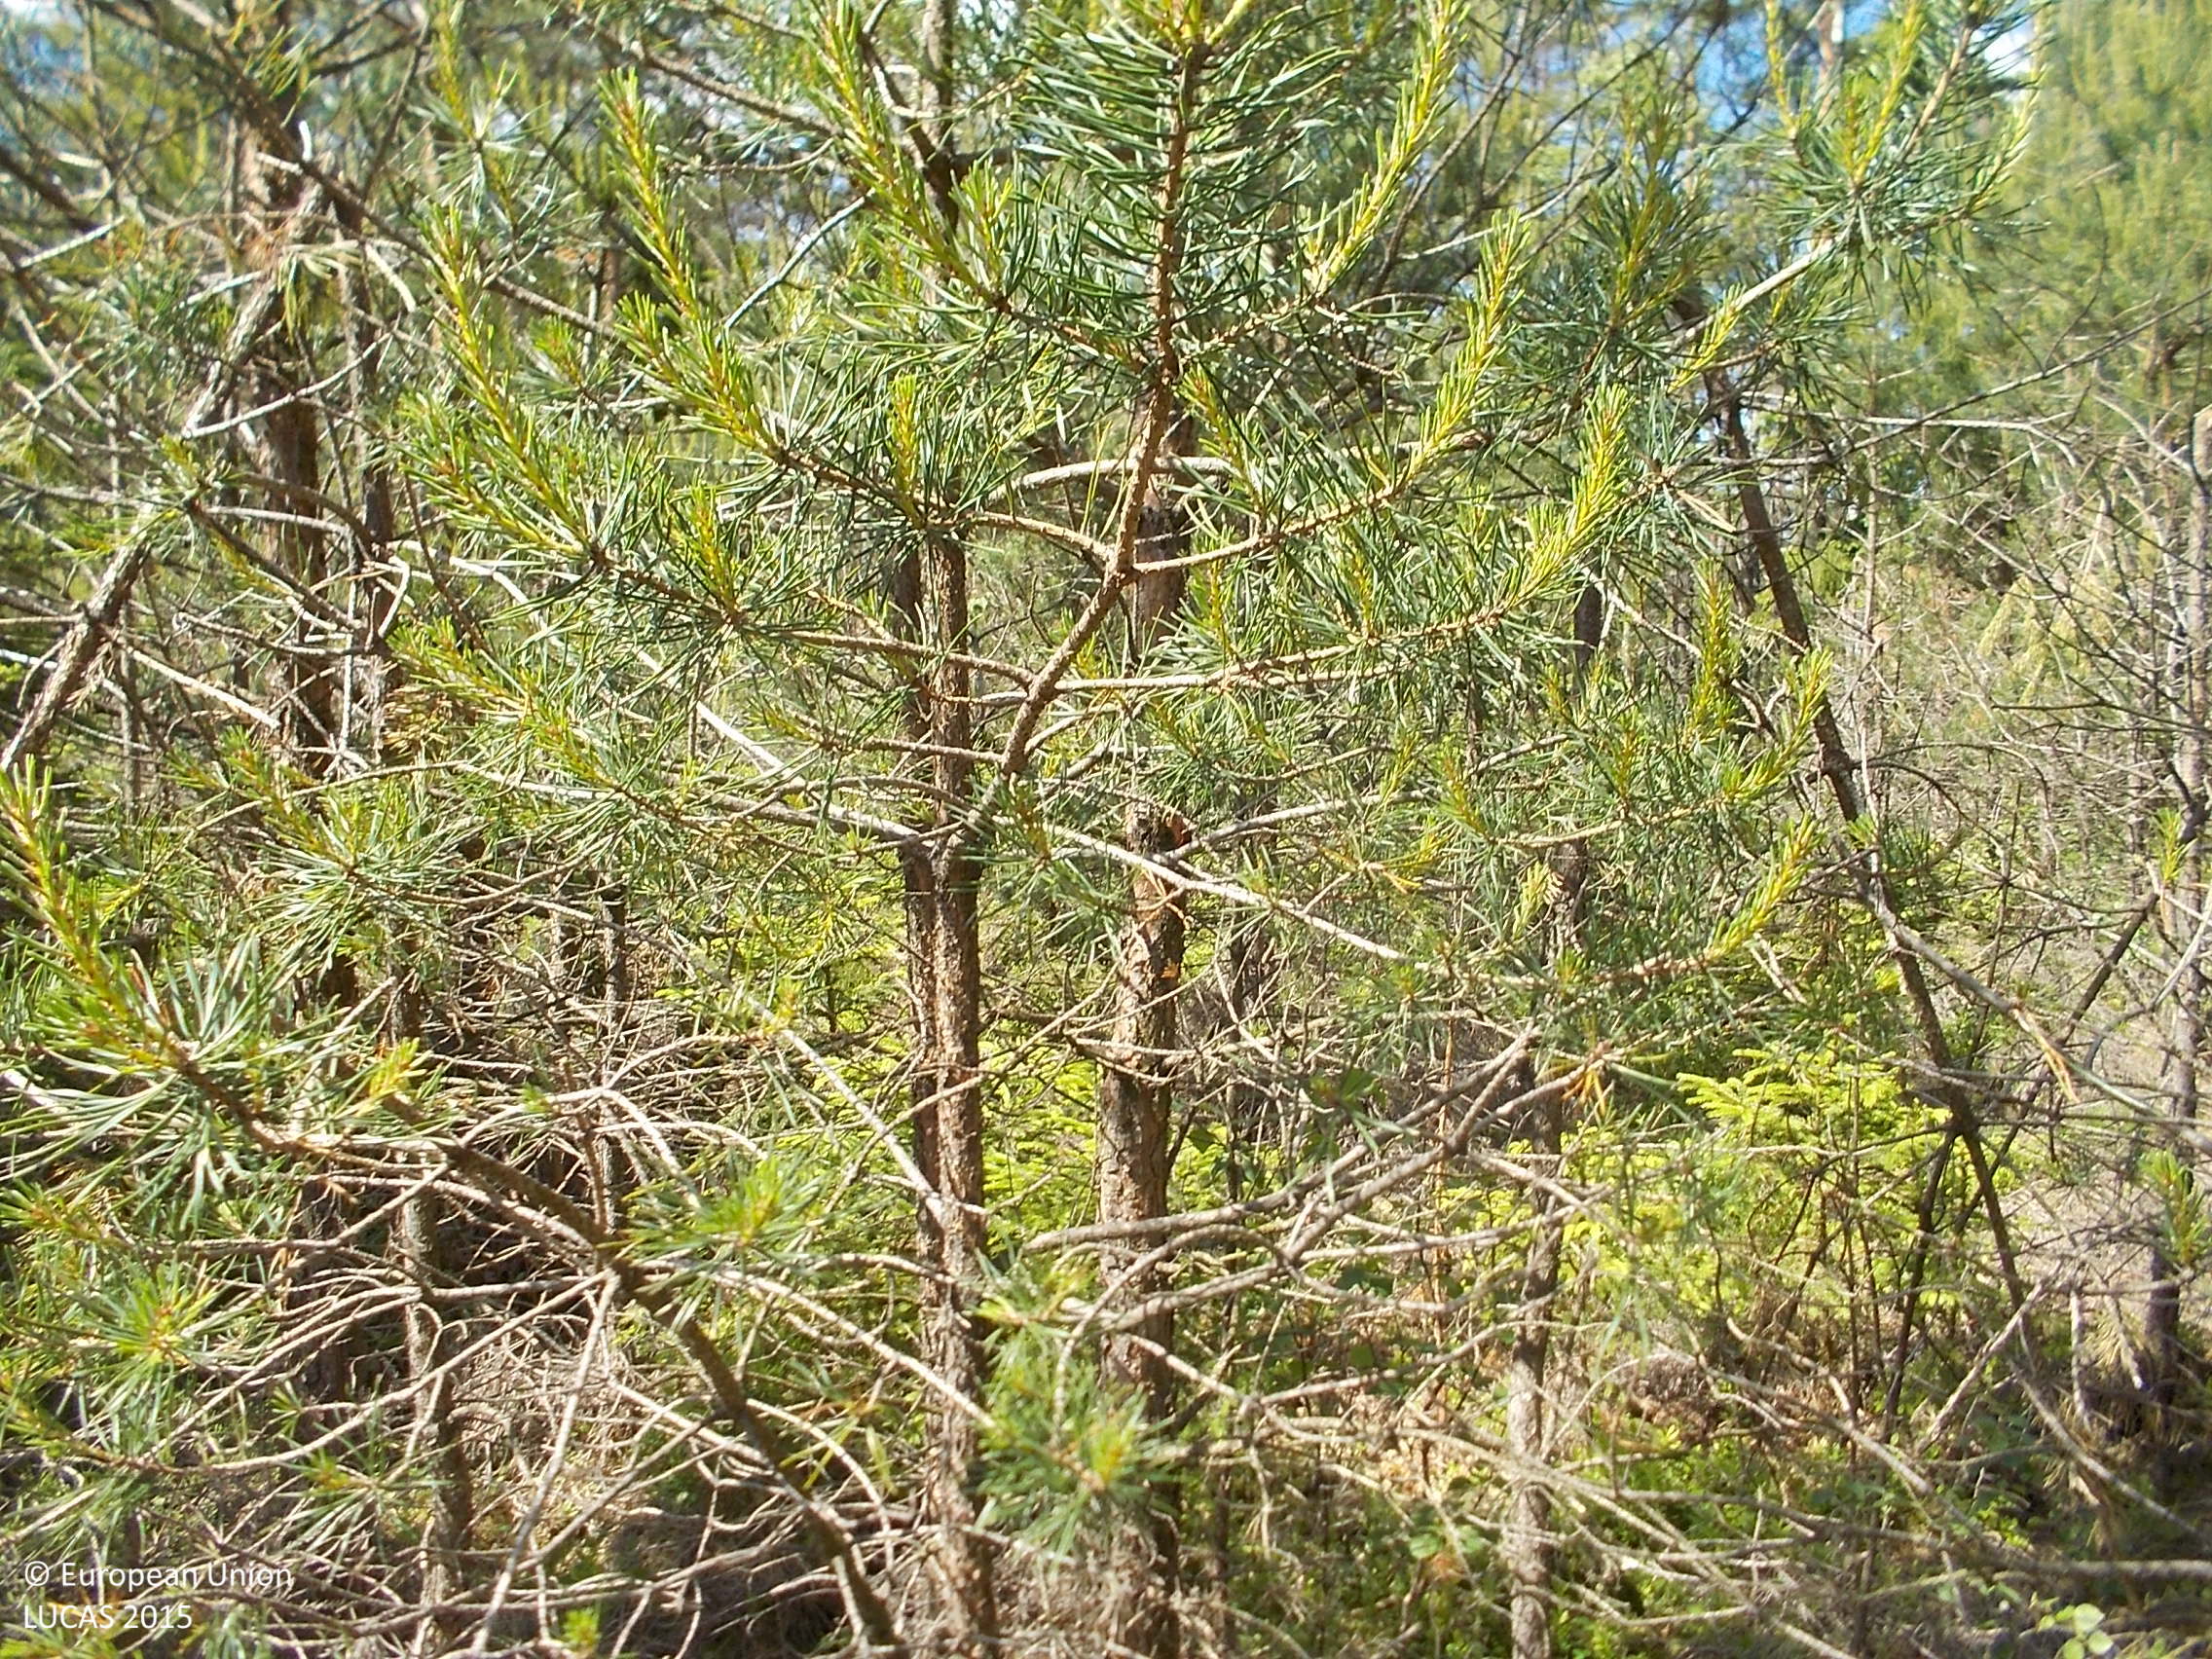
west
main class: Woodland
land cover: Pine dominated coniferous woodland
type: boreal forest
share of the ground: 50 - 75 %
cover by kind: coniferous forest trees 70 %, shrubs 25 %, broadleaved forest trees 5 %
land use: Forestry
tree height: < 5 m
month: June
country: SE
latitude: 57.7501
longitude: 12.2981
